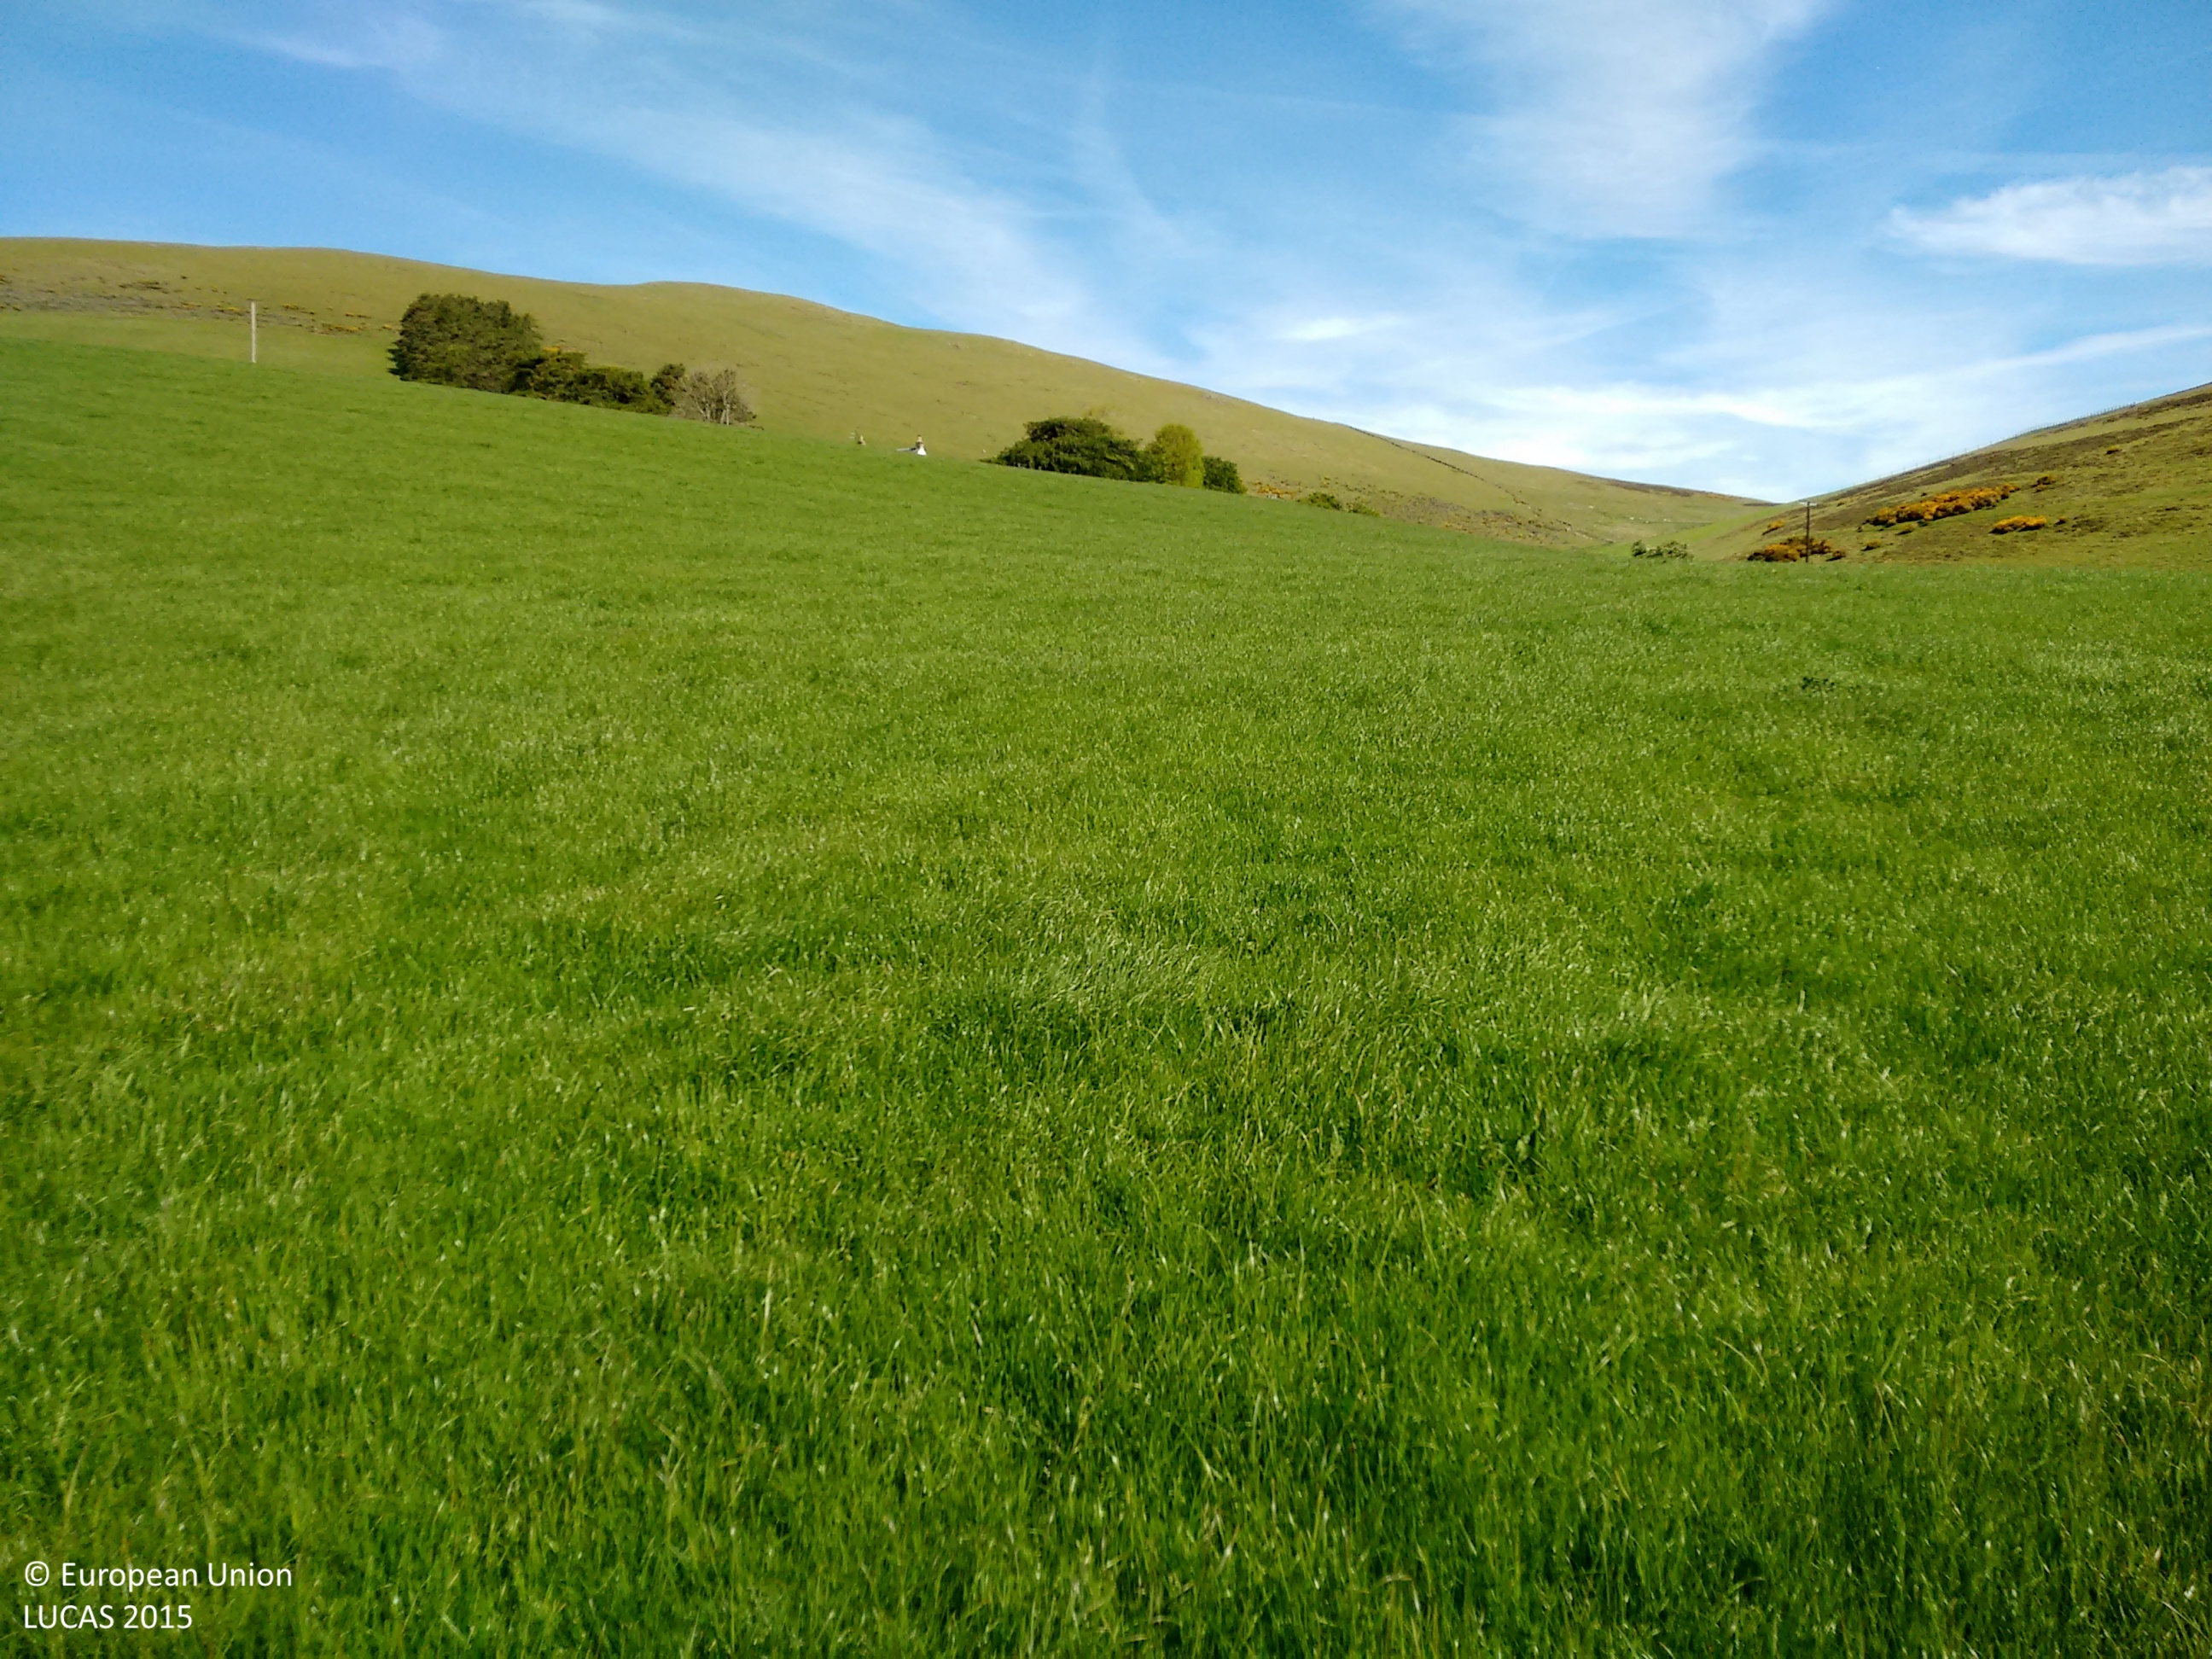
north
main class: Grassland
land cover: Grassland without tree/shrub cover
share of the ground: > 75 %
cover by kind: herbaceous plants 100 %
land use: Agriculture (excluding fallow land and kitchen gardens)
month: June
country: GB
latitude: 55.5989
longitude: -3.4891
